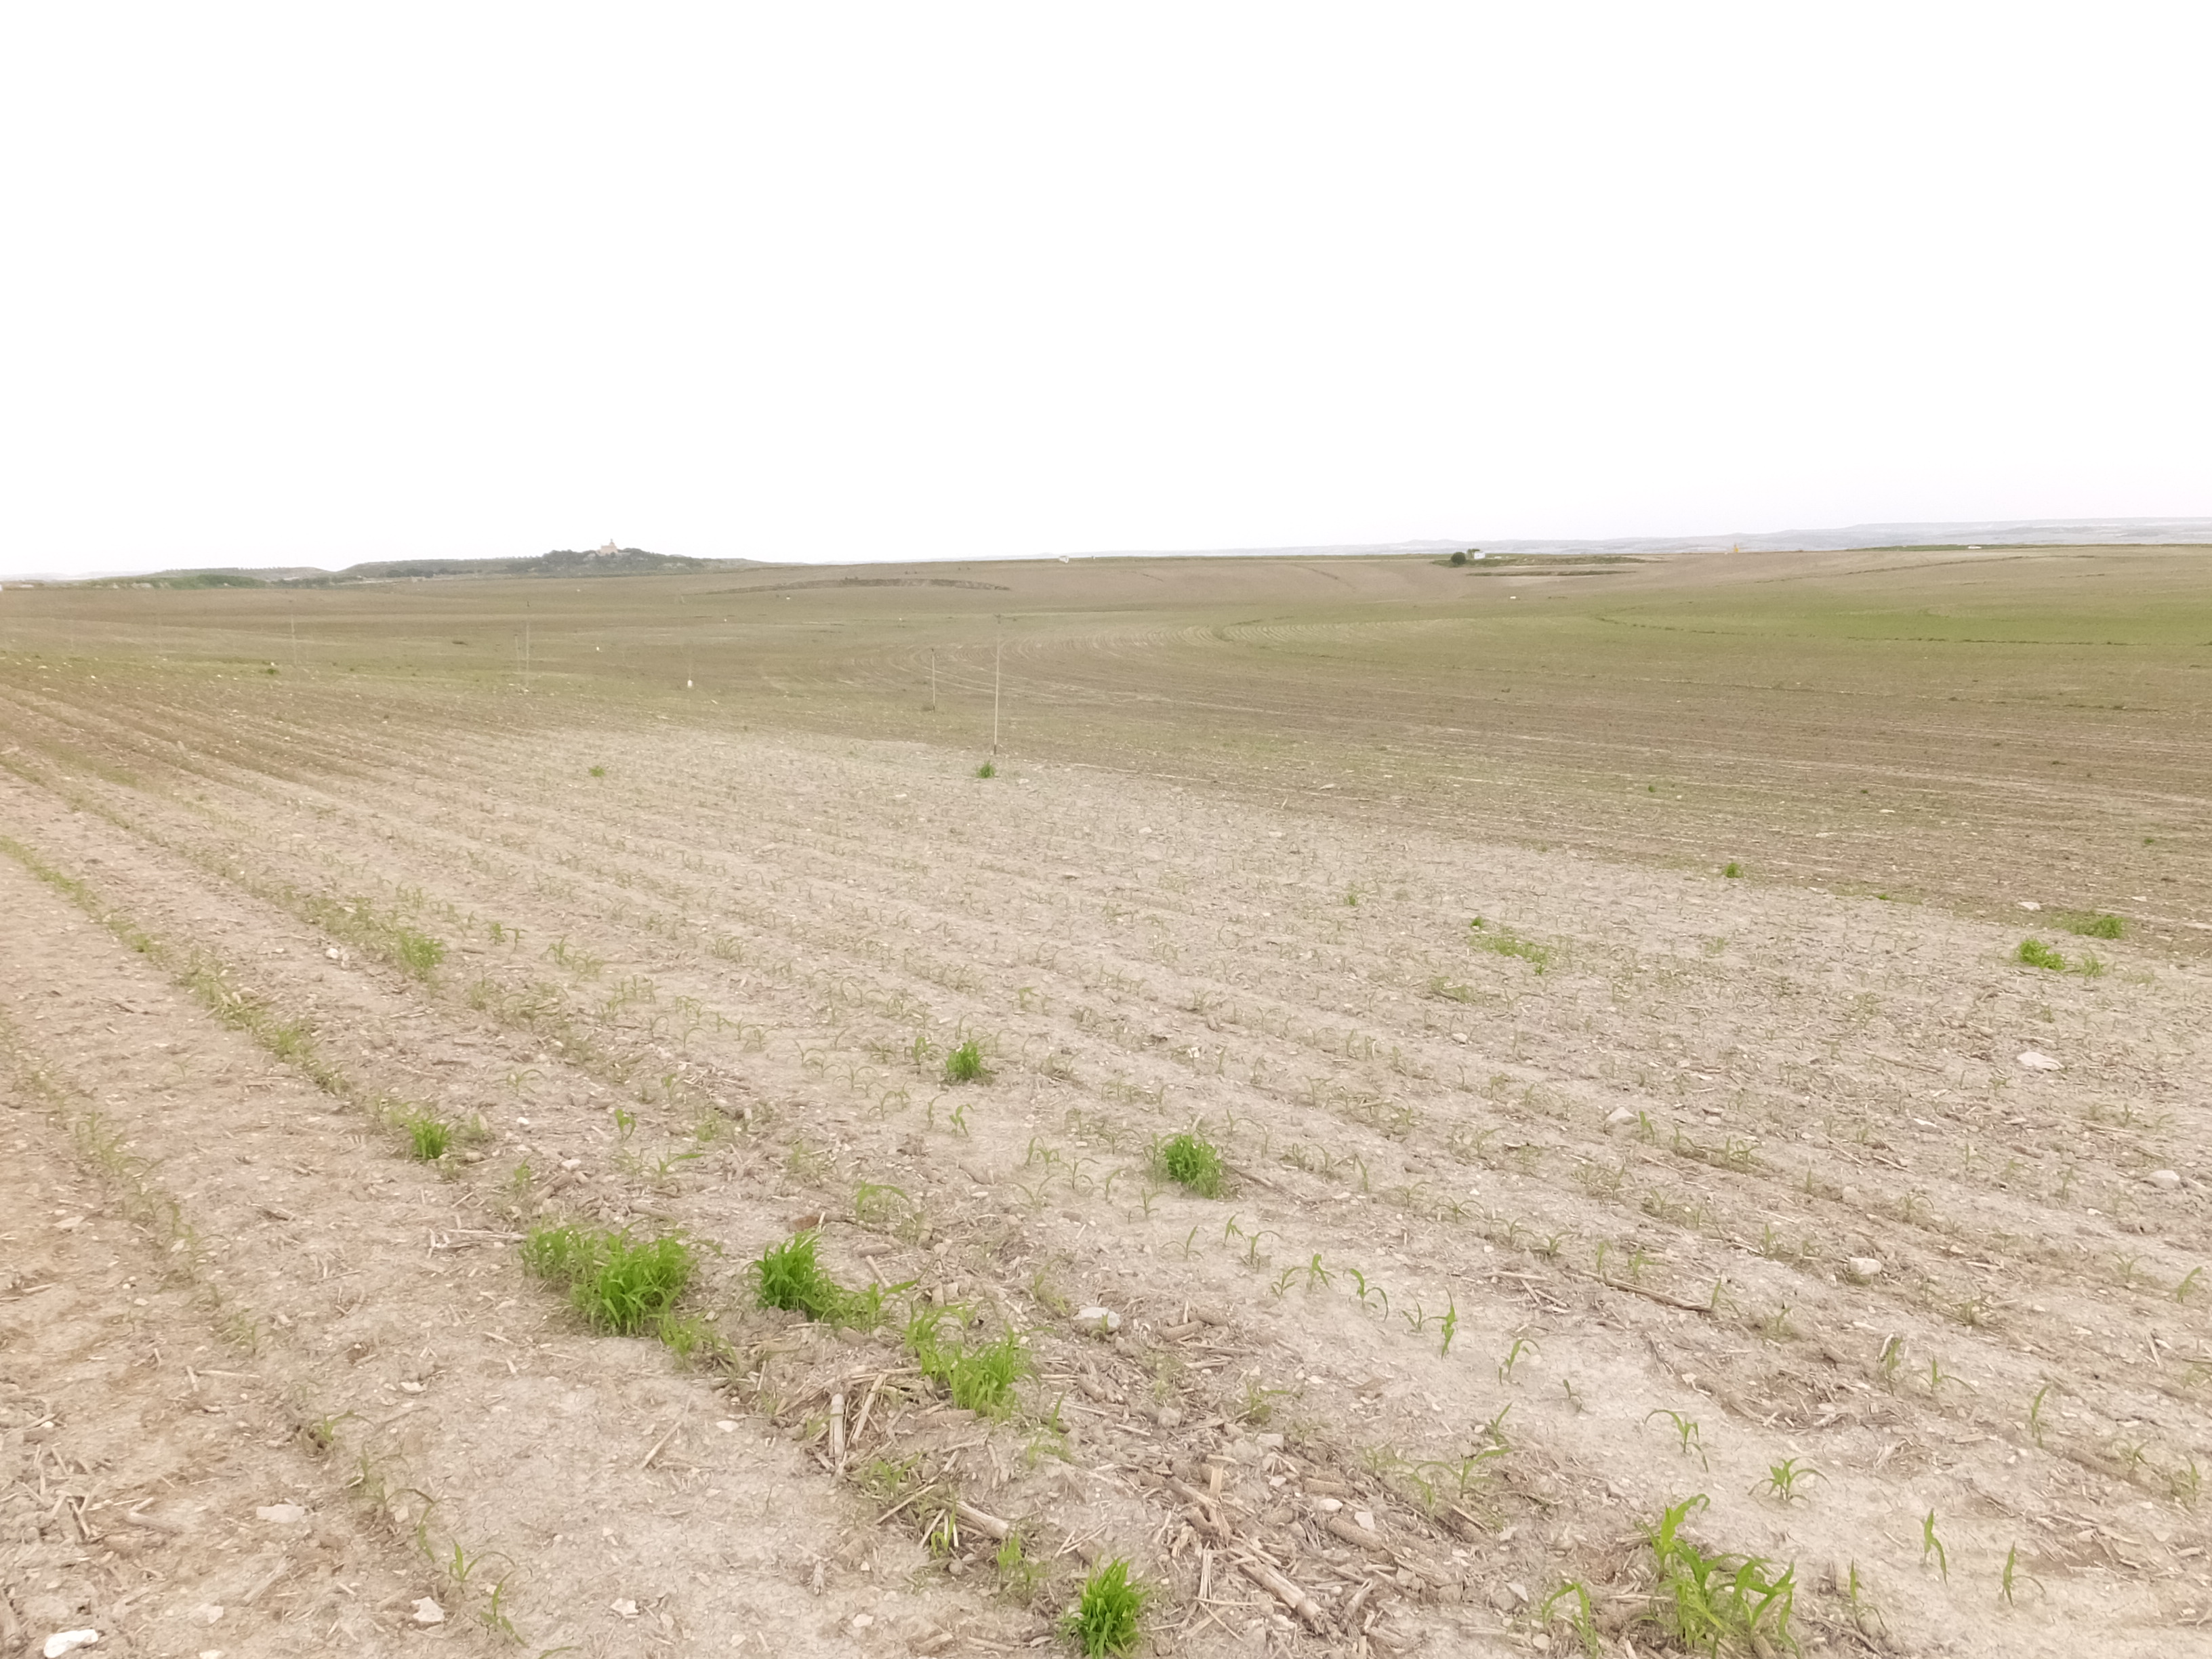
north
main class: Cropland
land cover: Maize
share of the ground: < 10 %
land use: Agriculture (excluding fallow land and kitchen gardens)
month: May
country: ES
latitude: 41.5454
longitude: -0.1214
